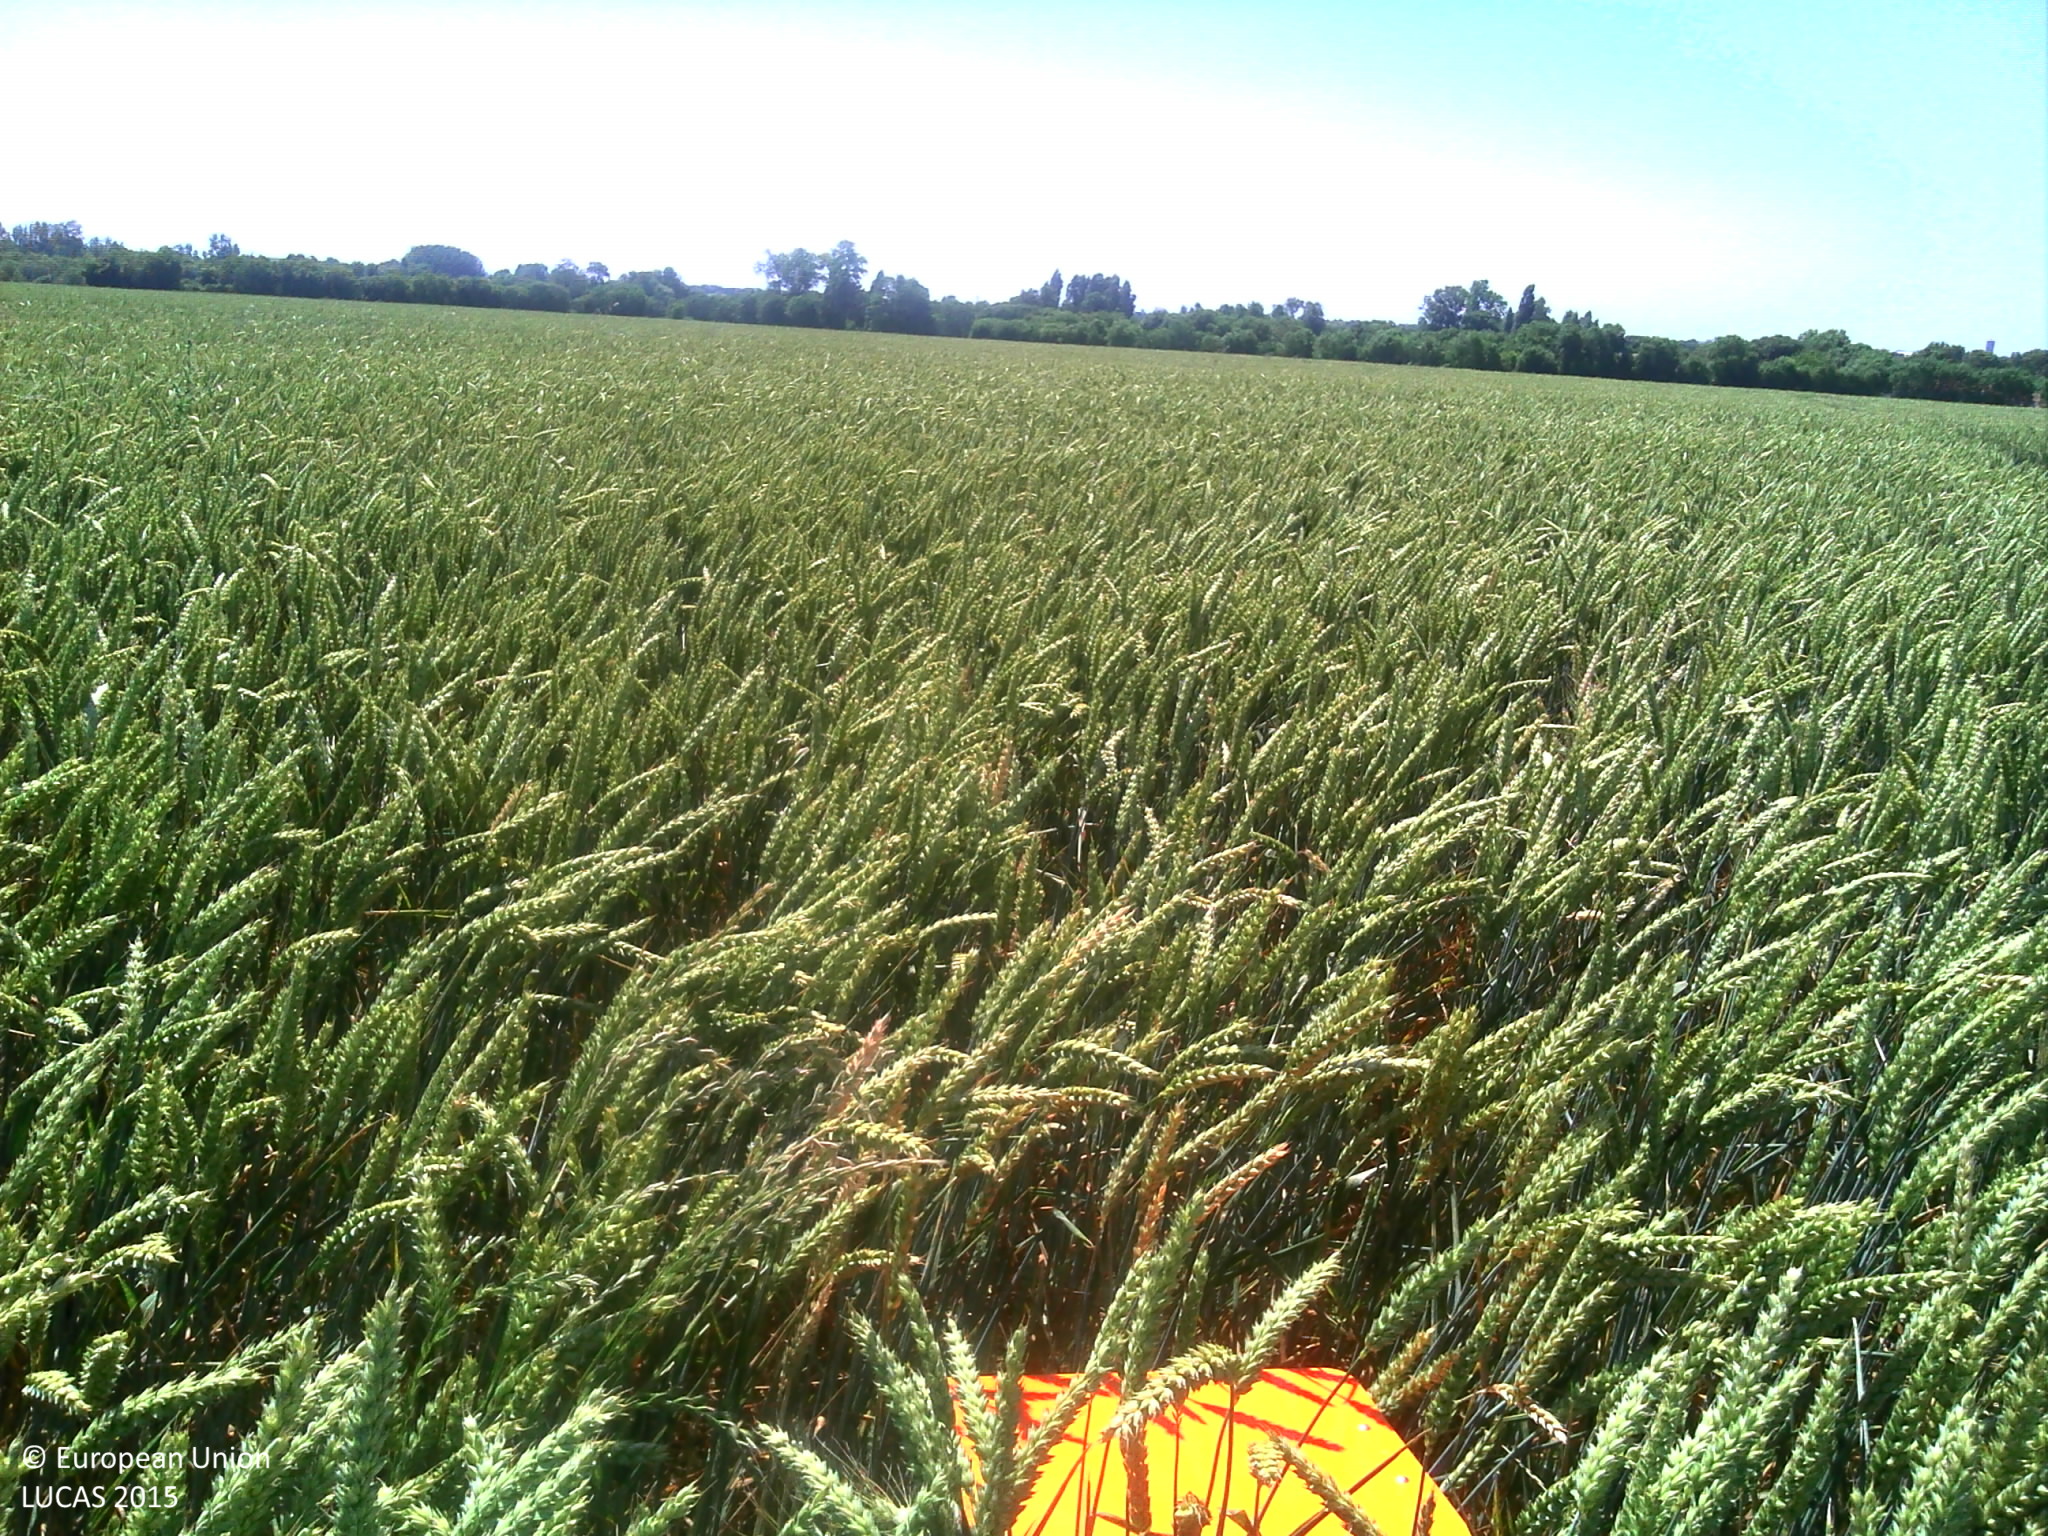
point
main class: Cropland
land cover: Common wheat
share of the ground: > 75 %
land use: Agriculture (excluding fallow land and kitchen gardens)
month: June
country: FR
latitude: 46.1486
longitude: -0.9701
